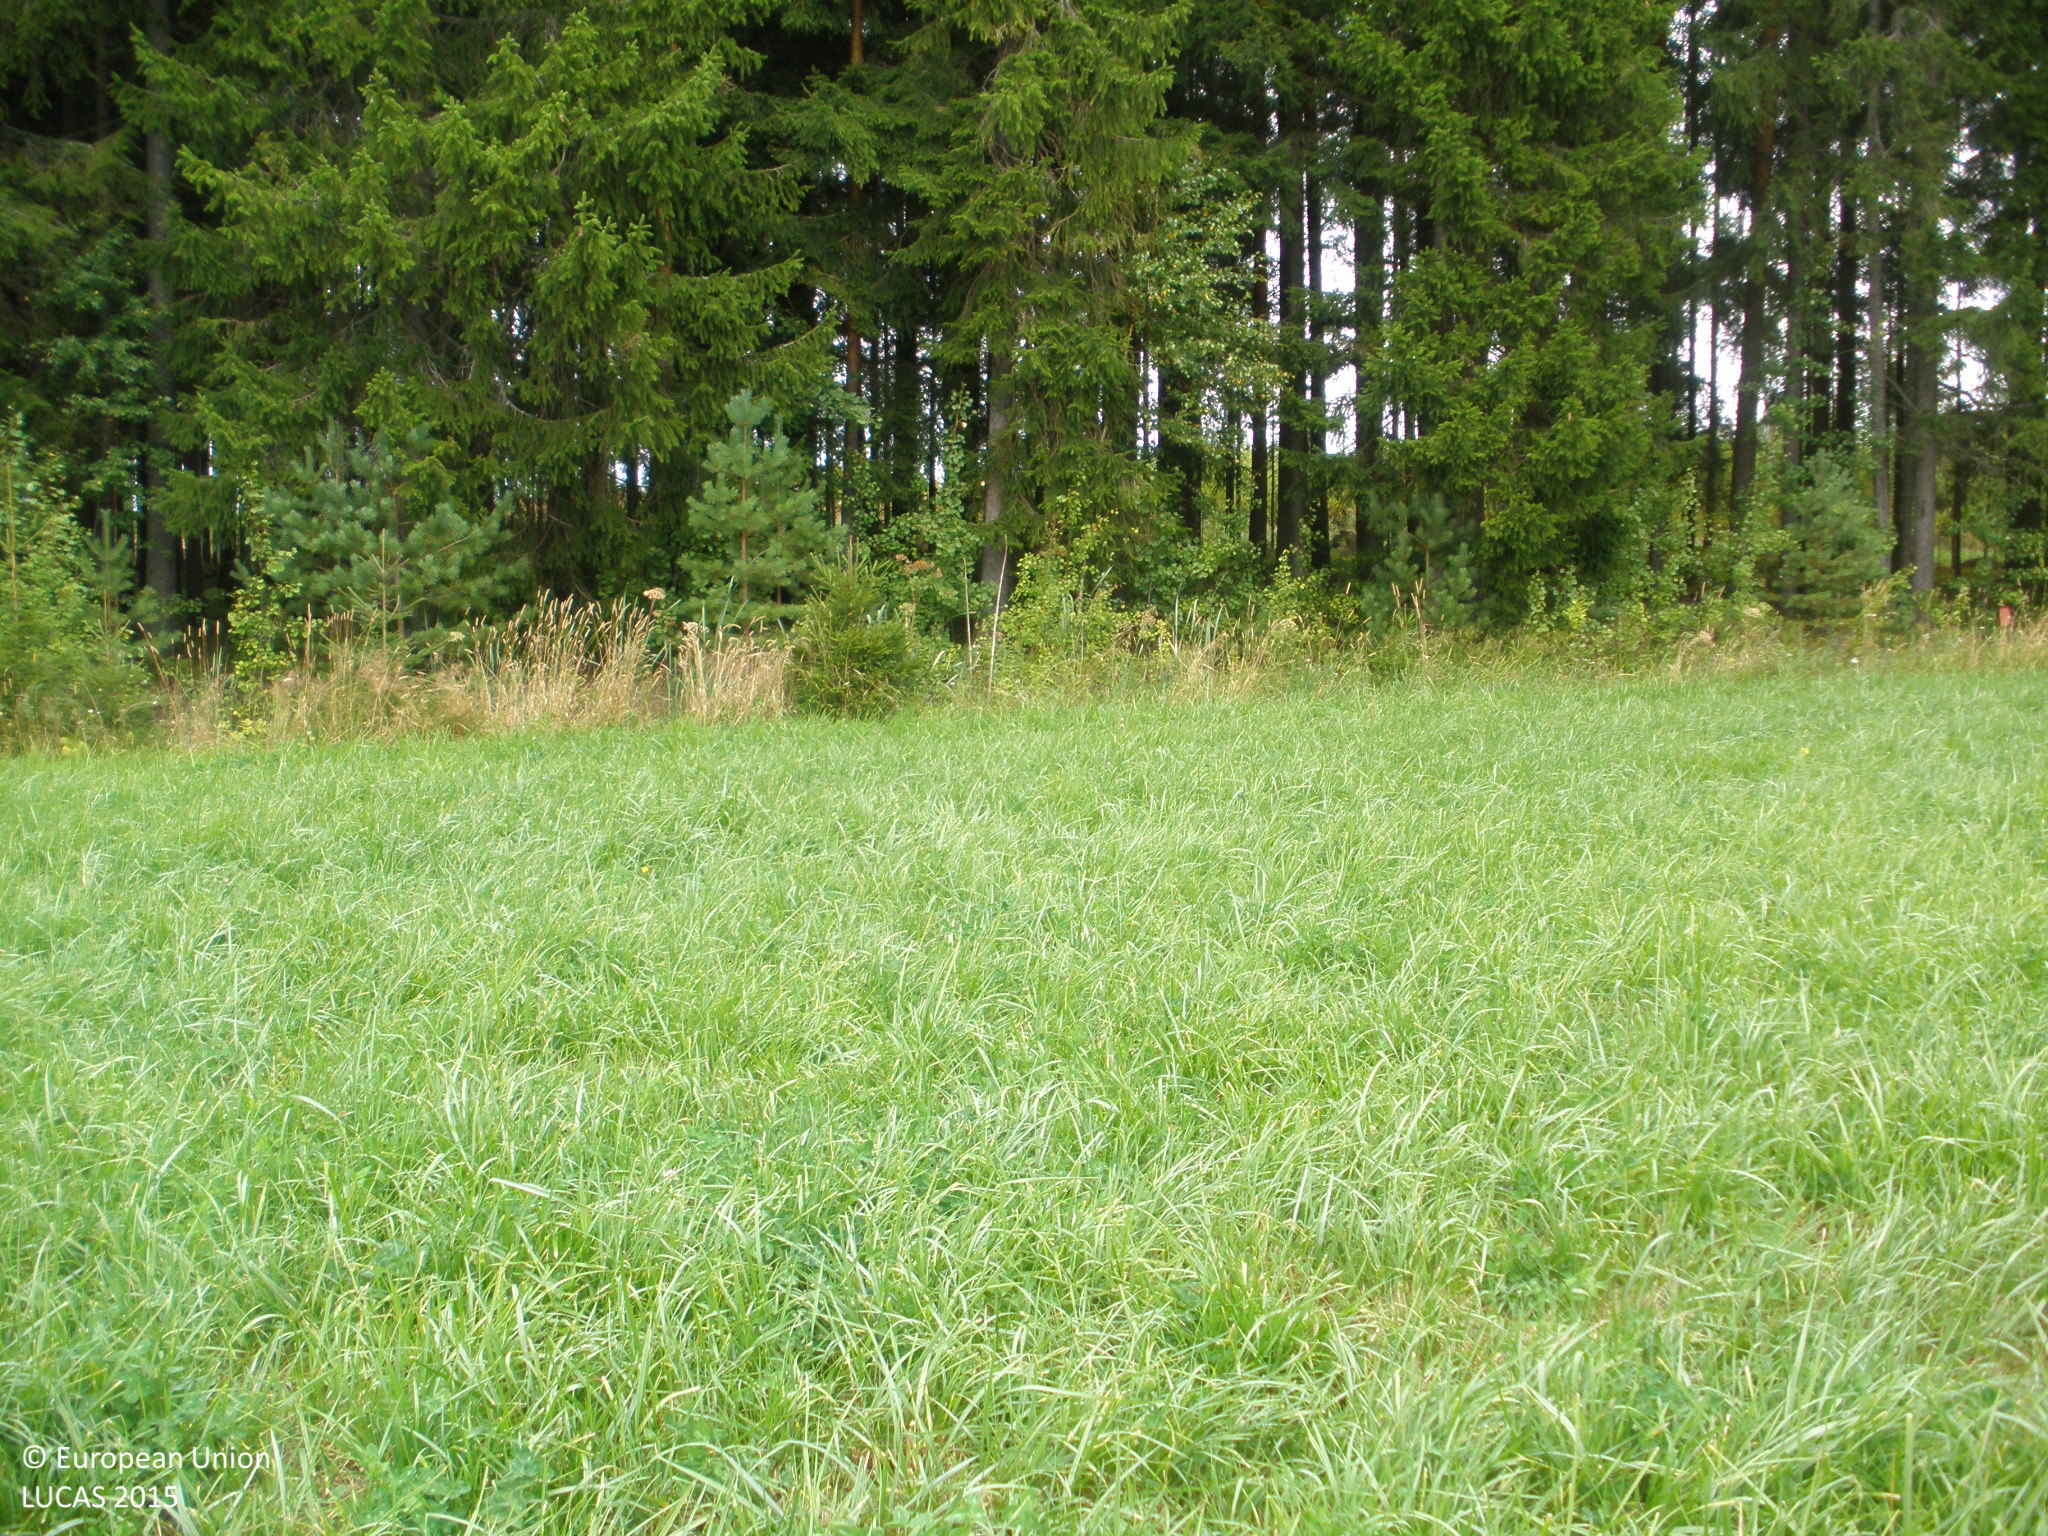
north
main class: Cropland
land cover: Temporary grasslands
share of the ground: > 75 %
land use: Agriculture (excluding fallow land and kitchen gardens)
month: August
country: FI
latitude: 60.5715
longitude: 23.4967
